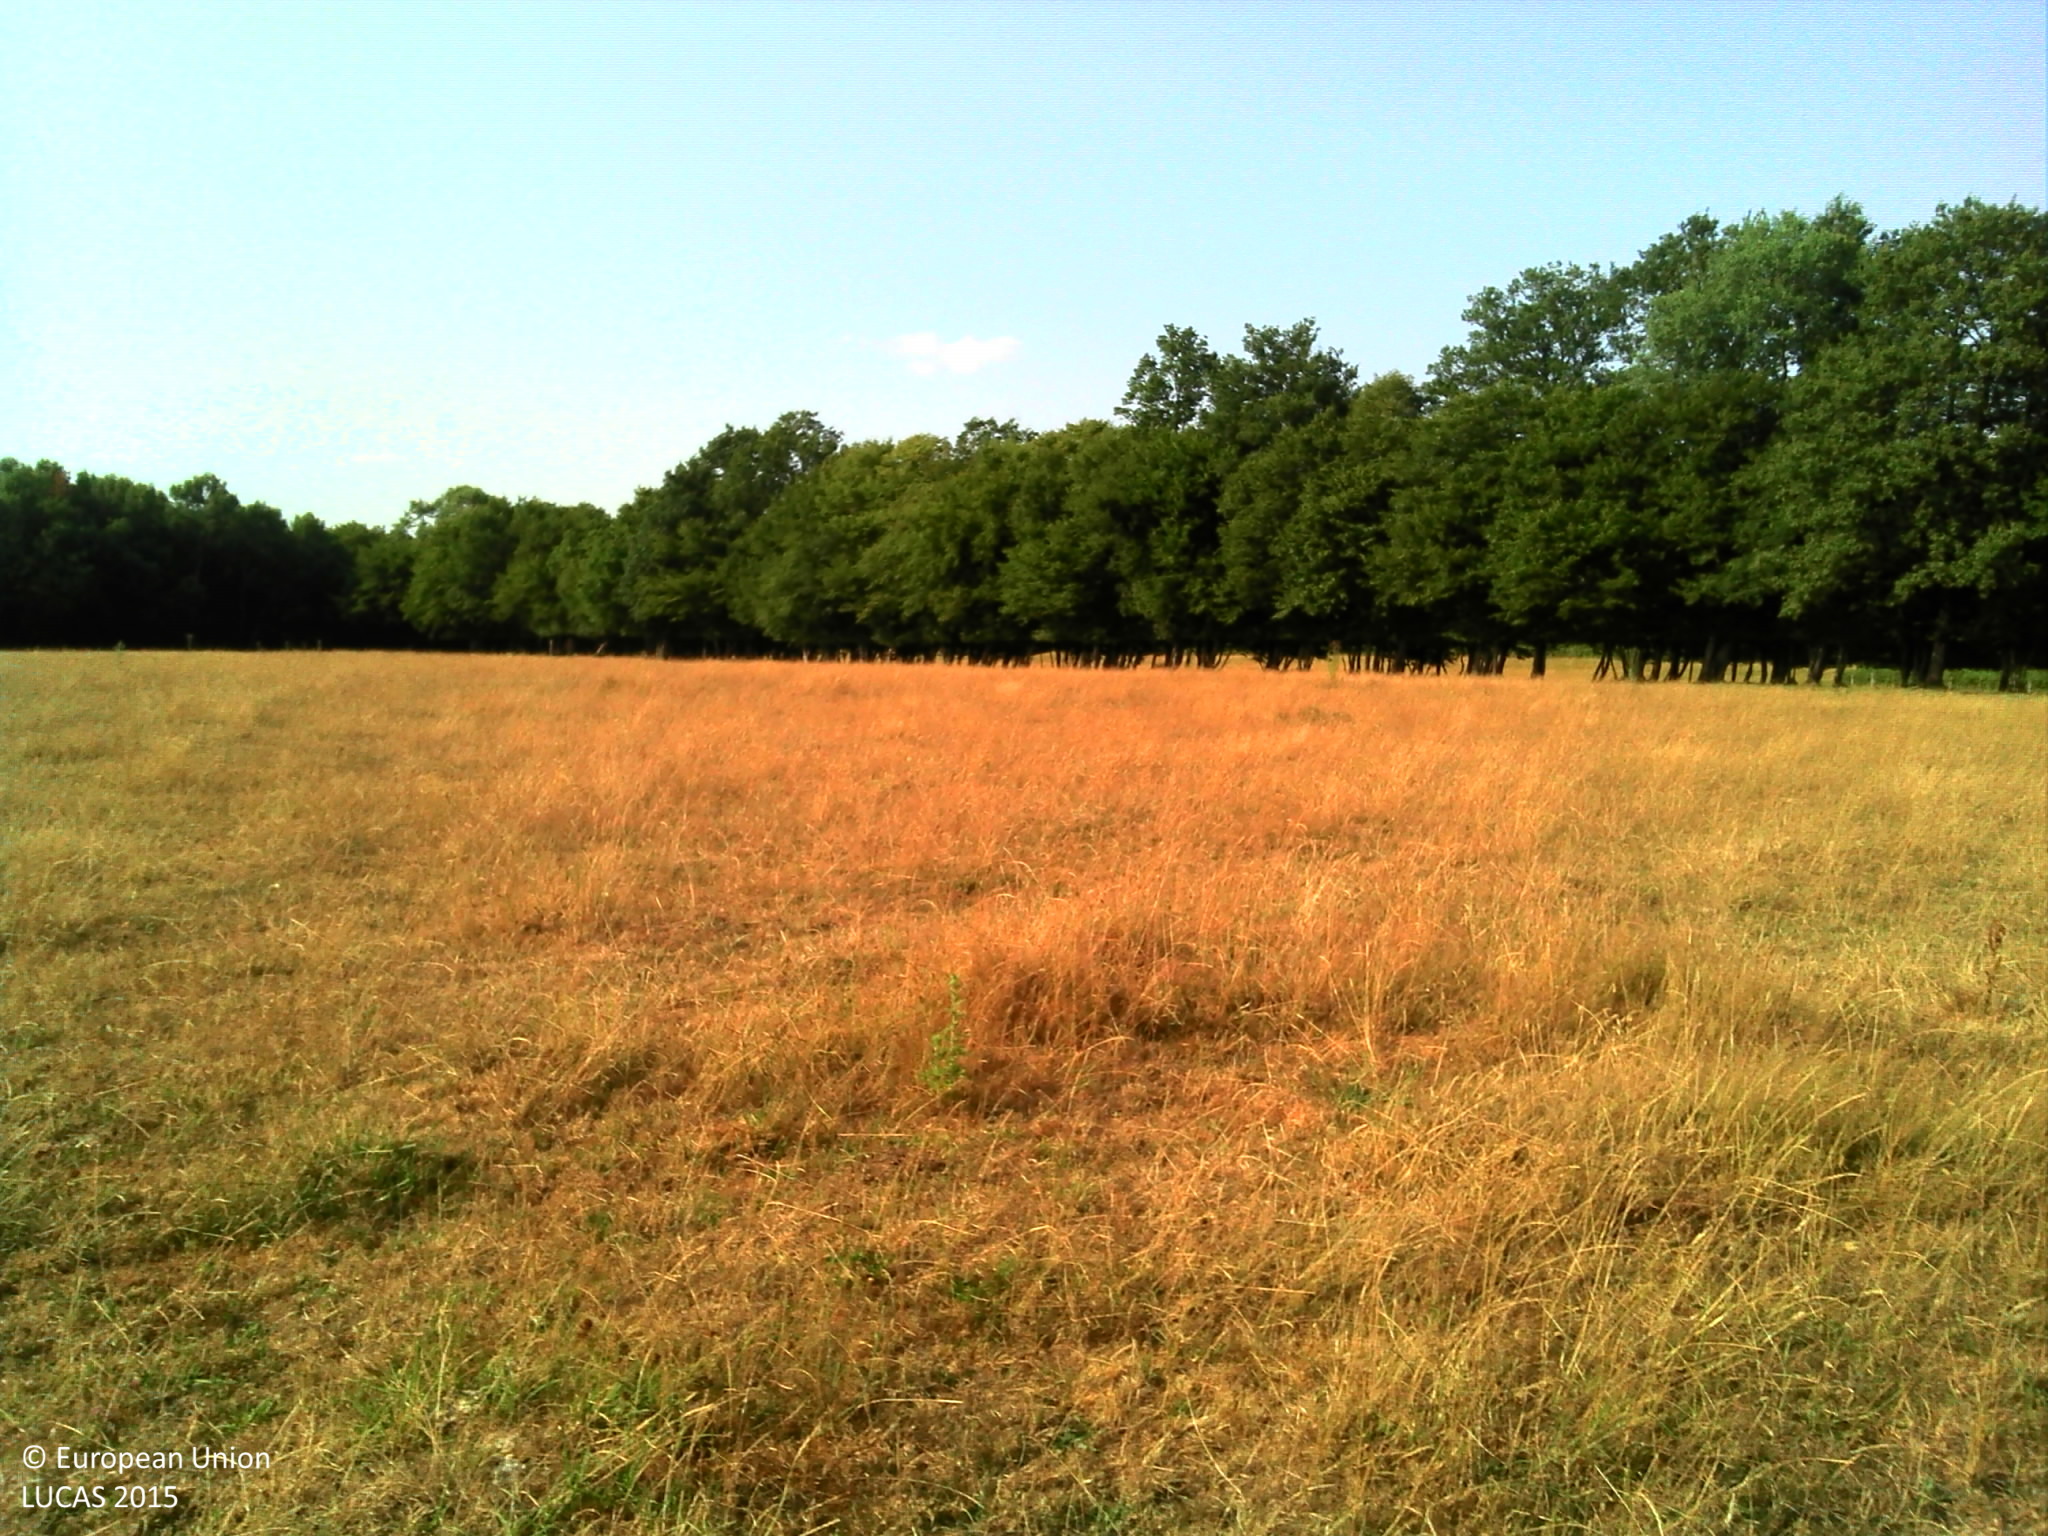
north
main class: Grassland
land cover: Grassland without tree/shrub cover
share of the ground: > 75 %
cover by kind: herbaceous plants 100 %
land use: Agriculture (excluding fallow land and kitchen gardens)
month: July
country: FR
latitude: 46.8123
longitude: 3.6423
